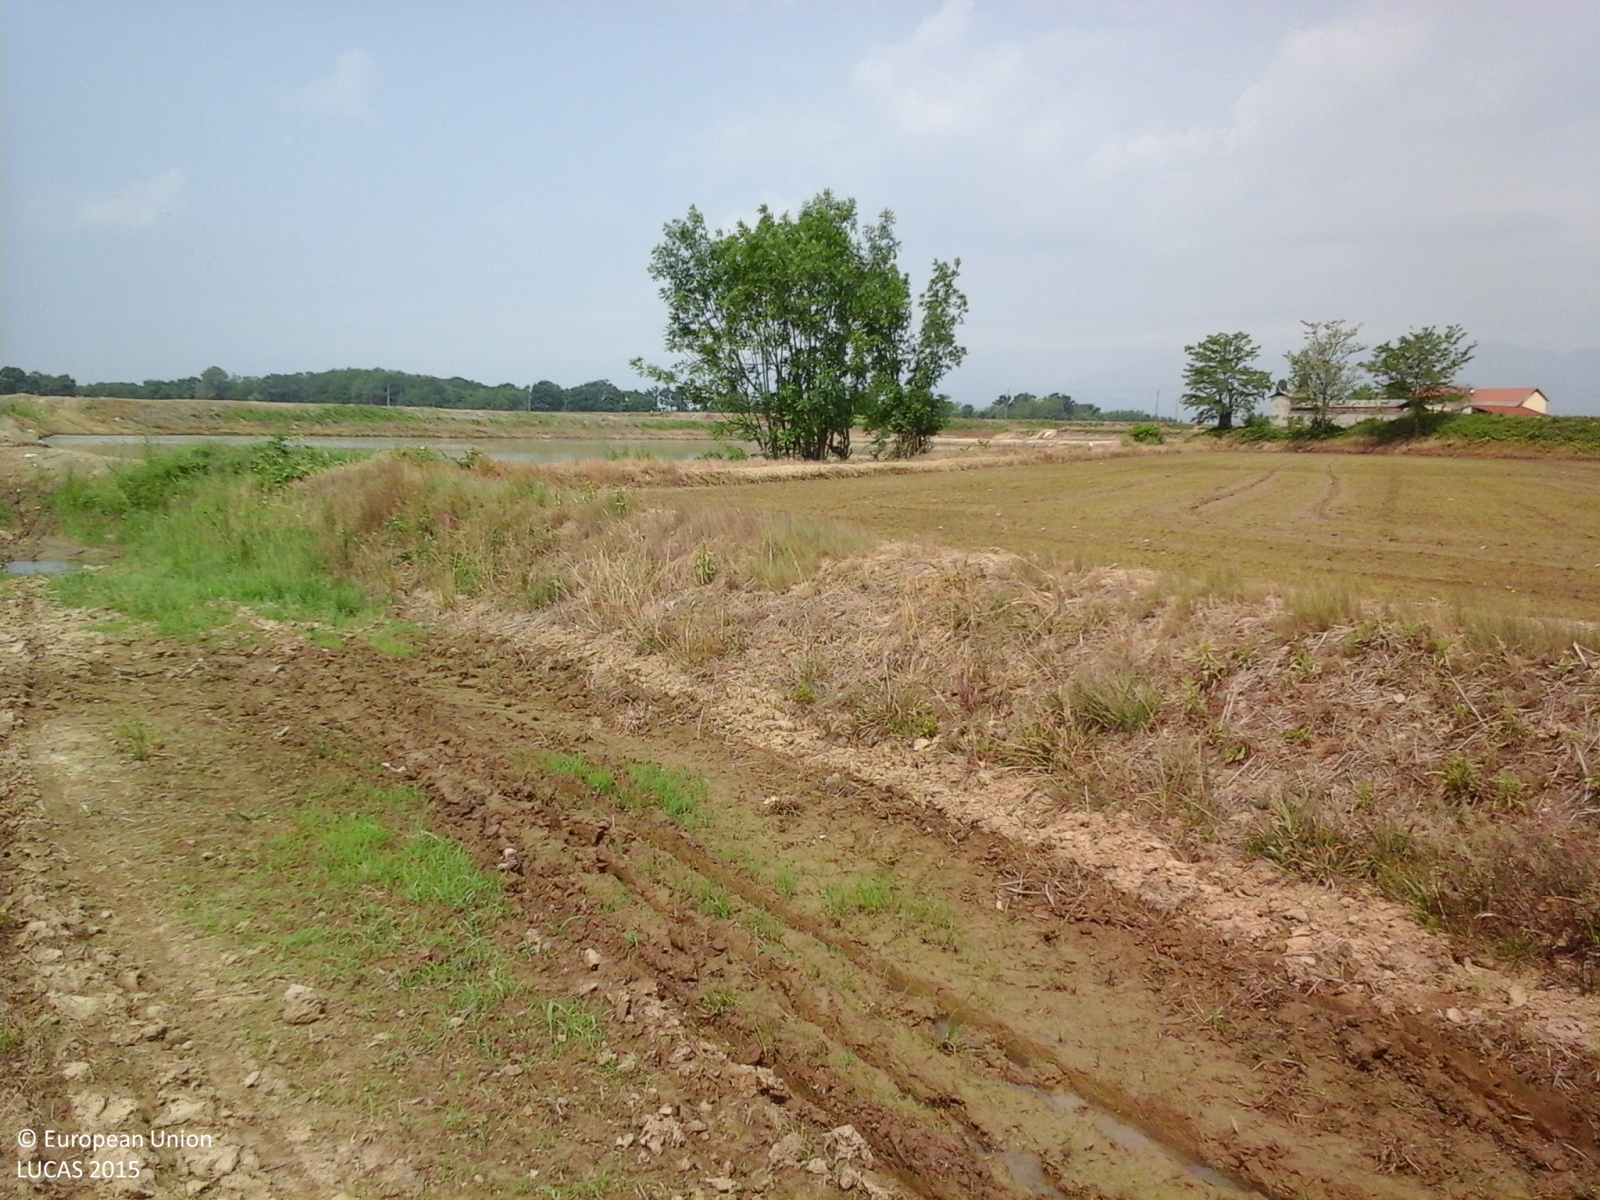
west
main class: Cropland
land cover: Rice
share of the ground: < 10 %
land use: Agriculture (excluding fallow land and kitchen gardens)
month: May
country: IT
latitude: 45.5083
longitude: 8.2749
